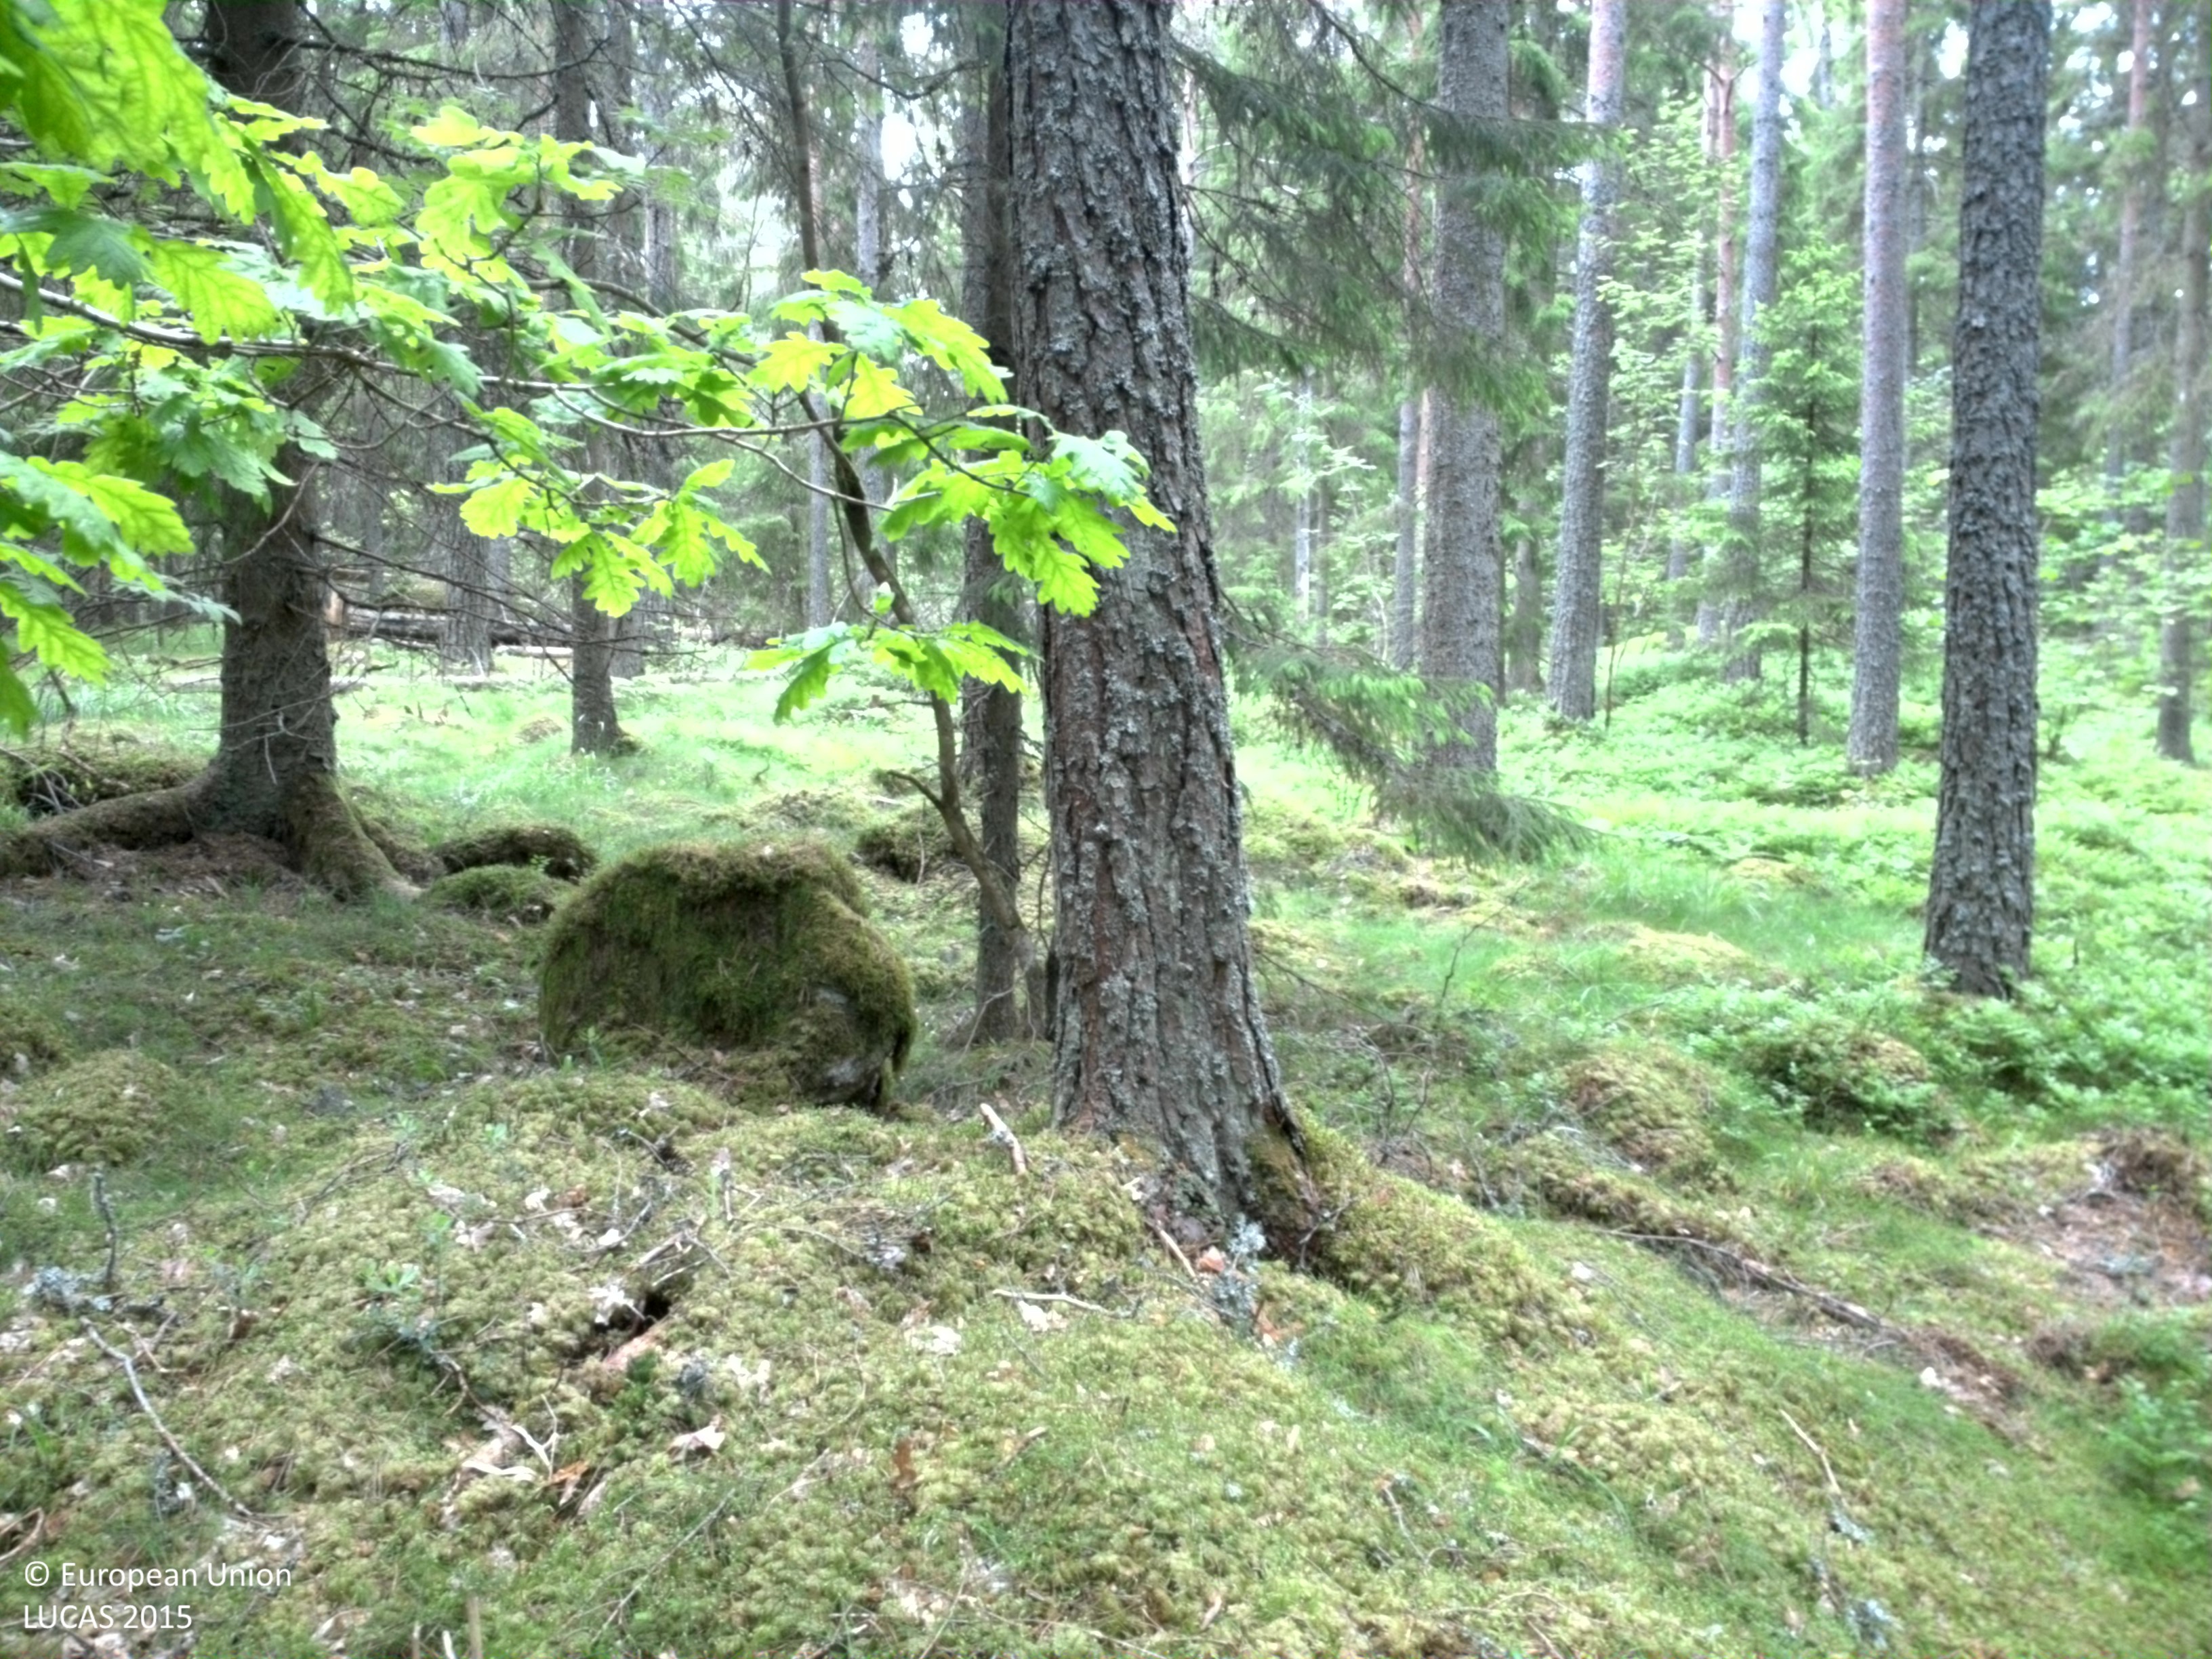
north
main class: Woodland
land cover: Spruce dominated coniferous woodland
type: boreal forest
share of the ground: 25 - 50 %
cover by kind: coniferous forest trees 40 %, herbaceous plants 35 %, lichens and mosses 20 %, broadleaved forest trees 5 %
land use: Forestry
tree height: > 5 m
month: June
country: SE
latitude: 58.7367
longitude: 15.5390
